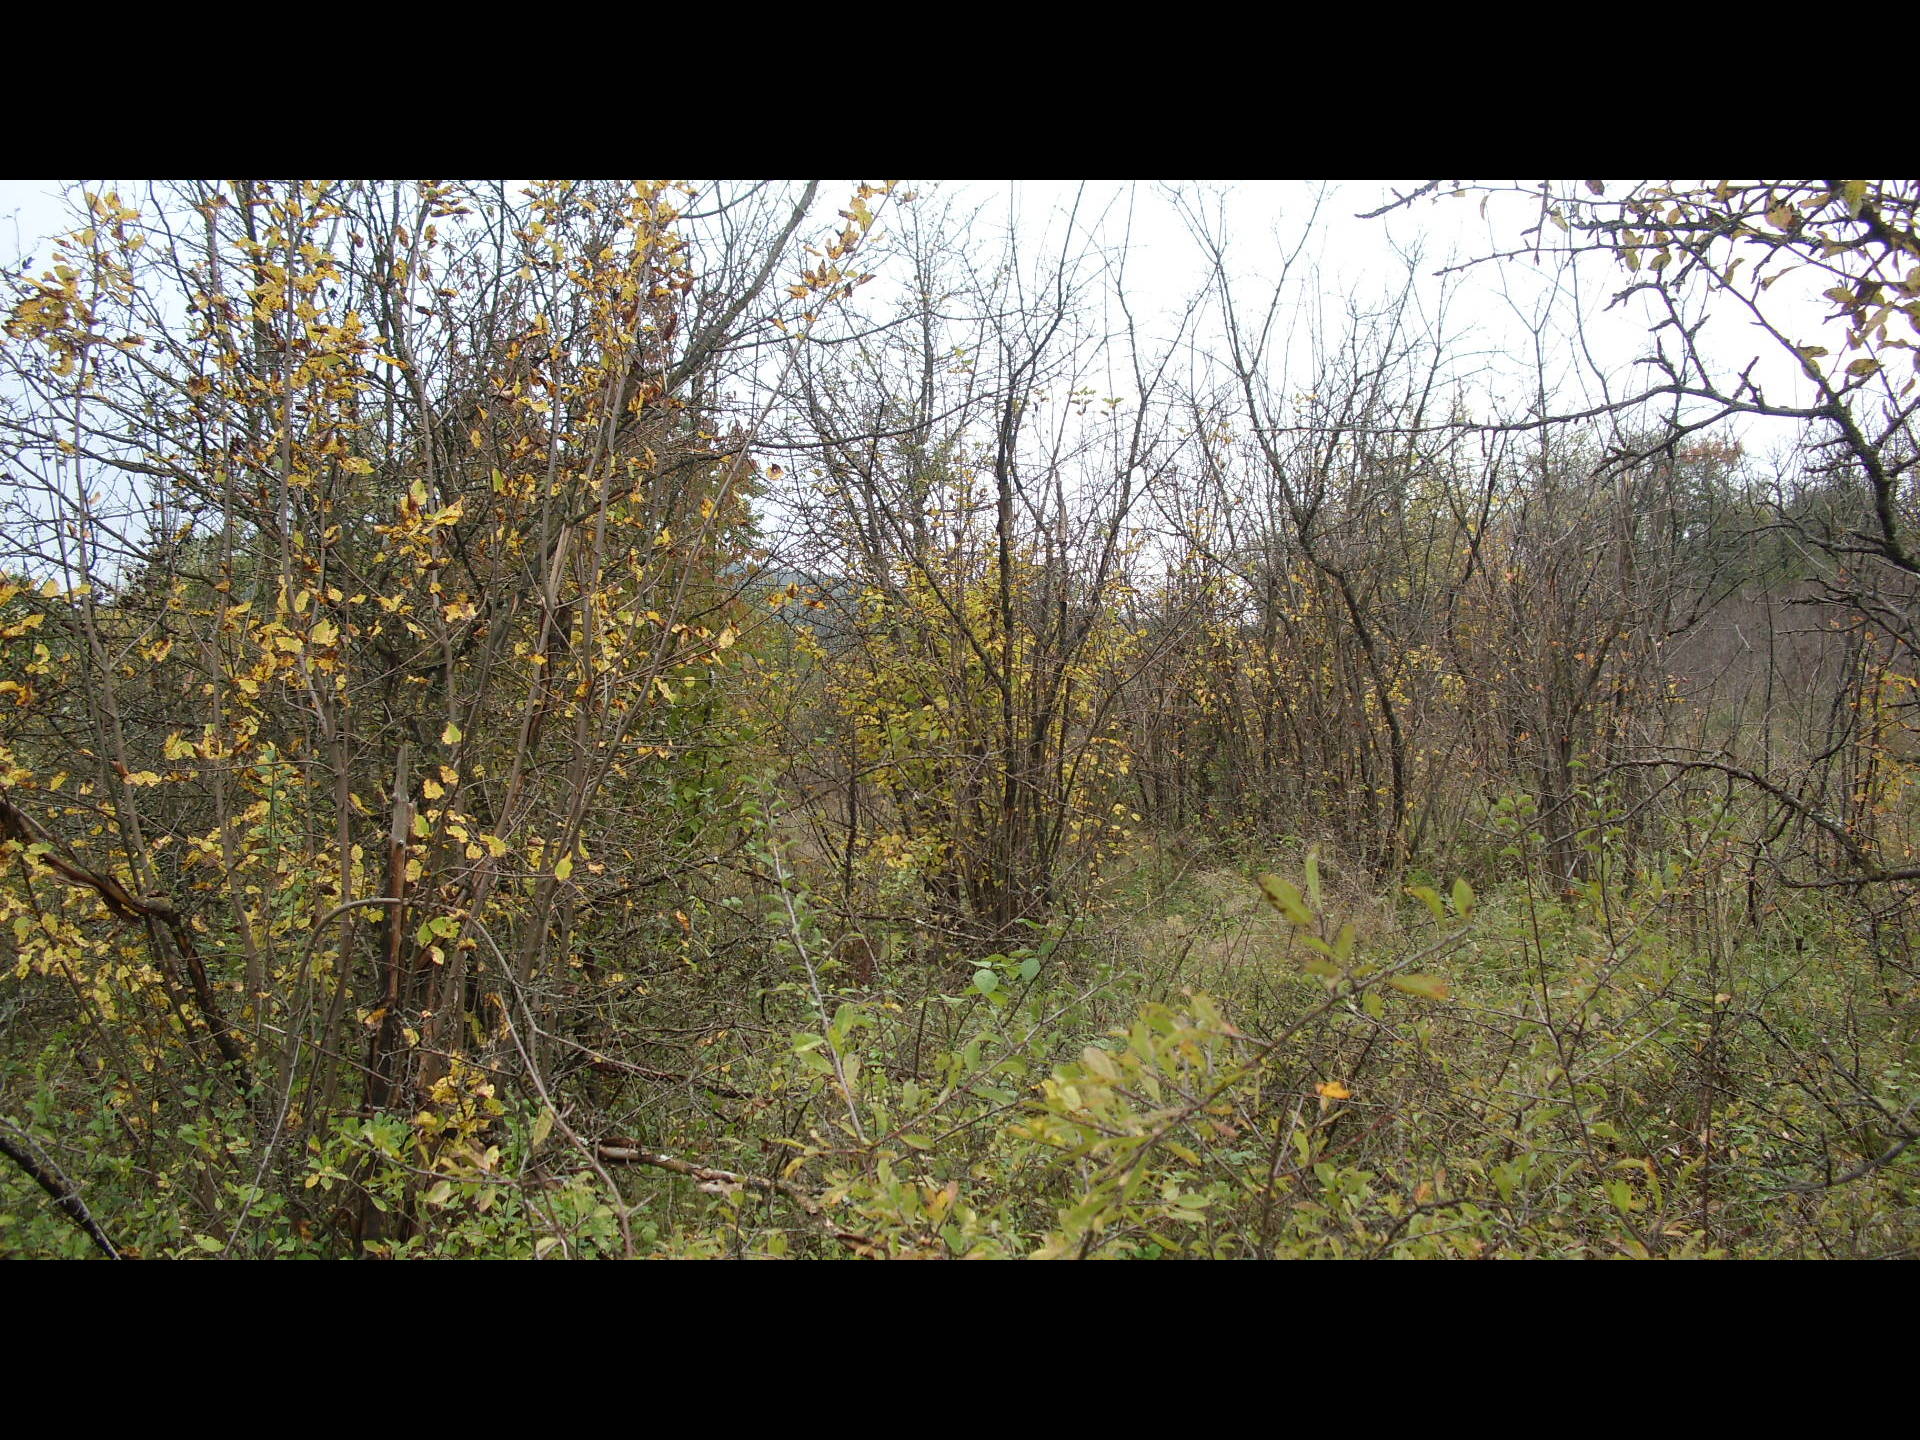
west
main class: Shrubland
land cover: Shrubland with sparse tree cover
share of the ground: > 75 %
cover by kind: shrubs 85 %, herbaceous plants 10 %, broadleaved forest trees 5 %
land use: Semi-natural and natural areas not in use
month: October
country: BG
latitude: 43.6707
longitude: 22.5968
